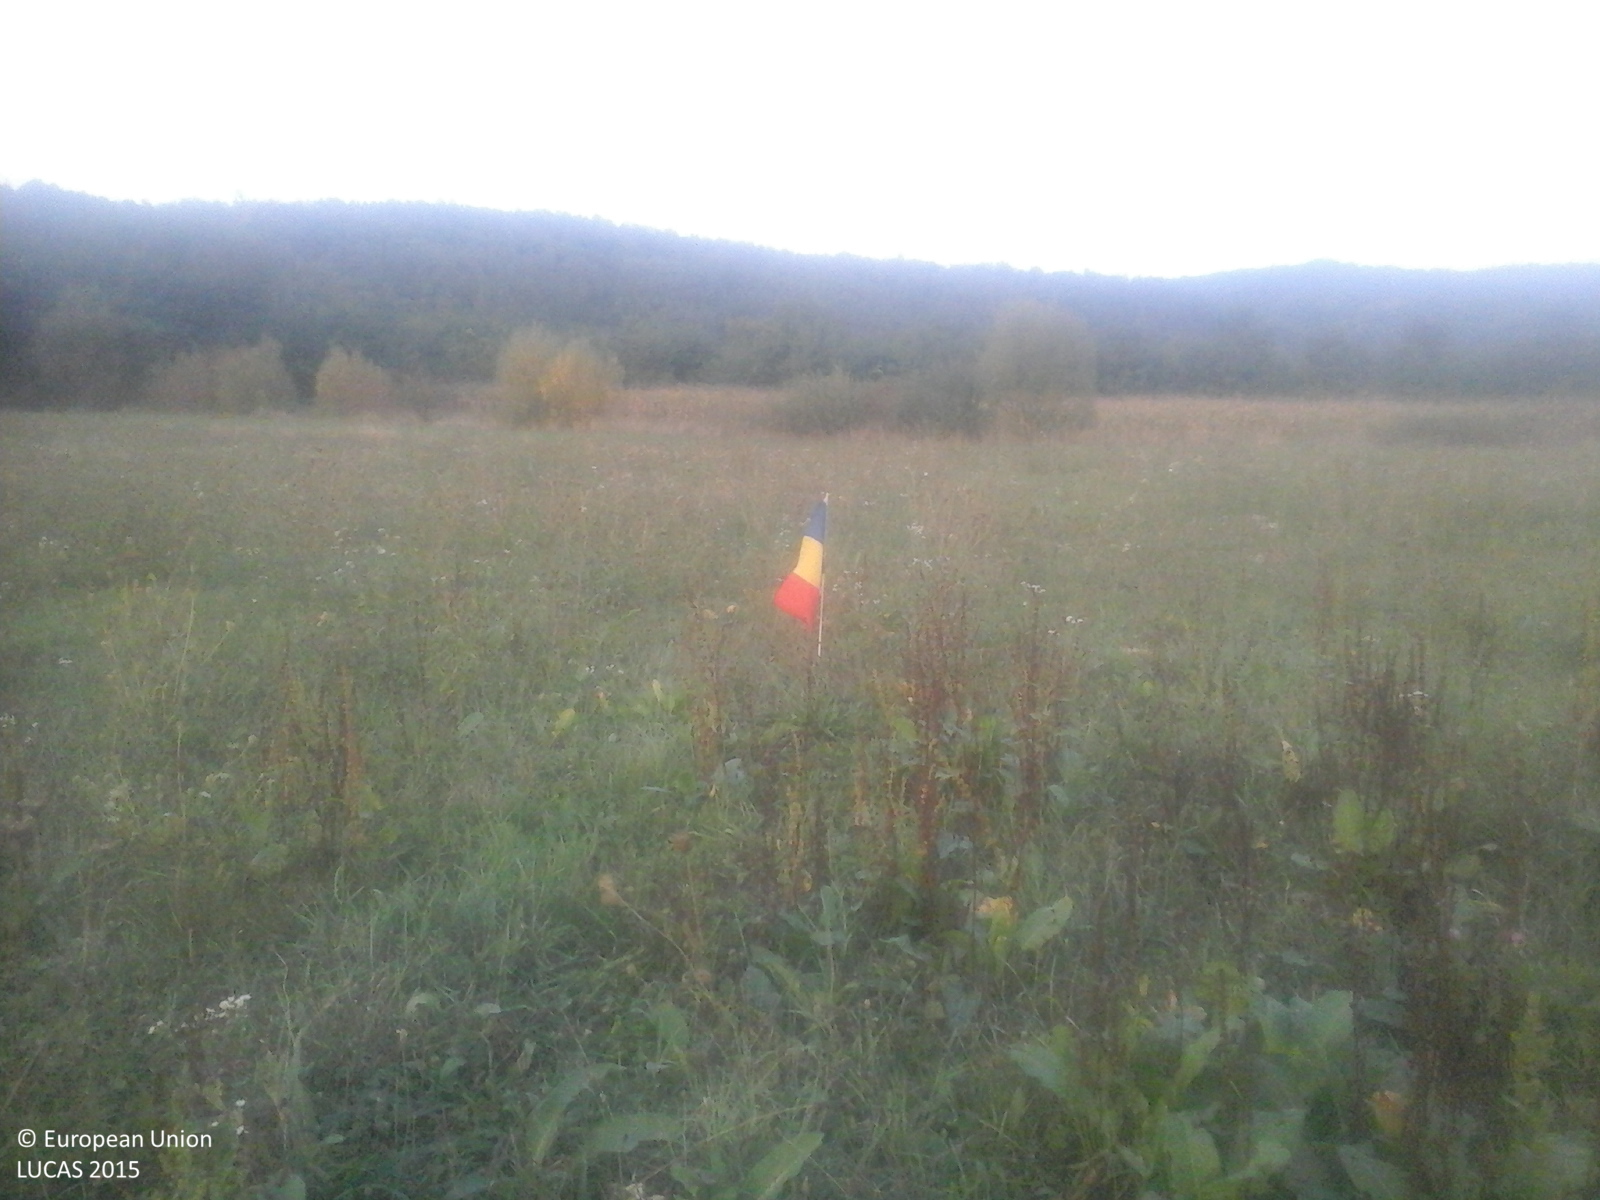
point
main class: Grassland
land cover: Spontaneously vegetated surfaces
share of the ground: > 75 %
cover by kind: herbaceous plants 100 %
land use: Fallow land
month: September
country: RO
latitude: 45.7007
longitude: 22.0750
